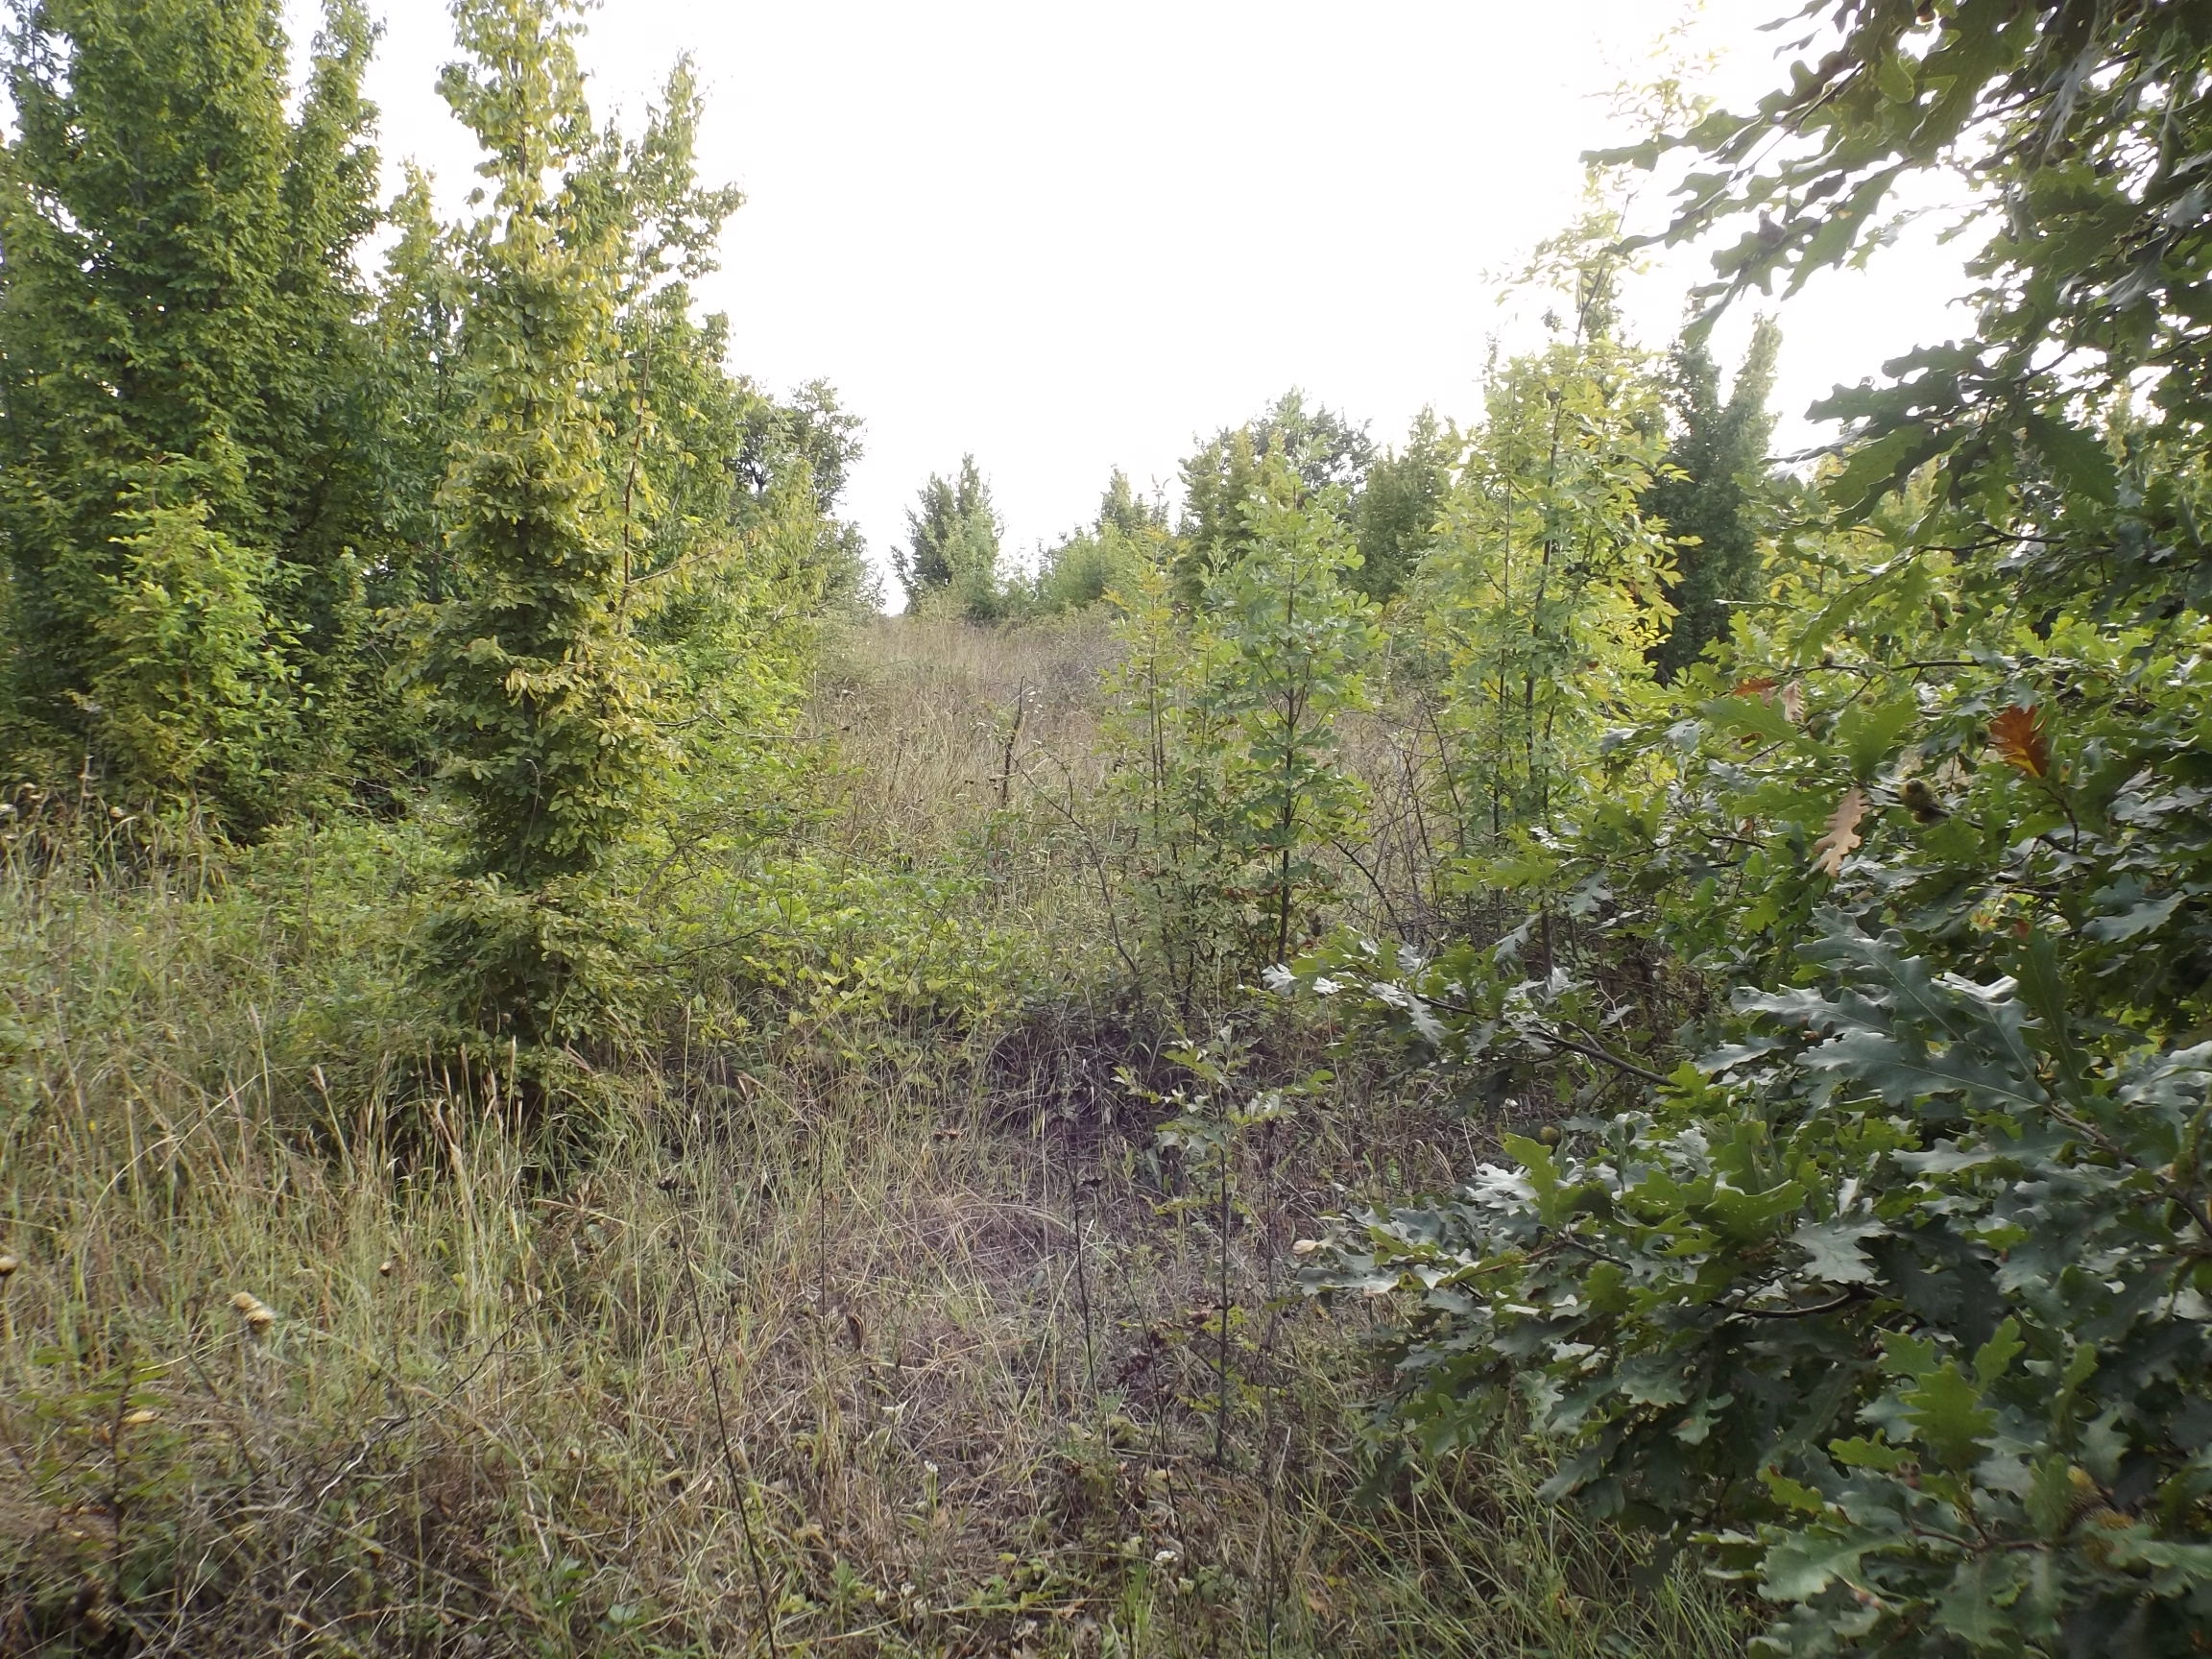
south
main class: Woodland
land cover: Broadleaved woodland
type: mesophytic deciduous forest
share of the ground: > 75 %
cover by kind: broadleaved forest trees 75 %, herbaceous plants 15 %, shrubs 10 %
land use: Forestry
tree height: > 5 m
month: September
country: BG
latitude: 43.2949
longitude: 28.0031
